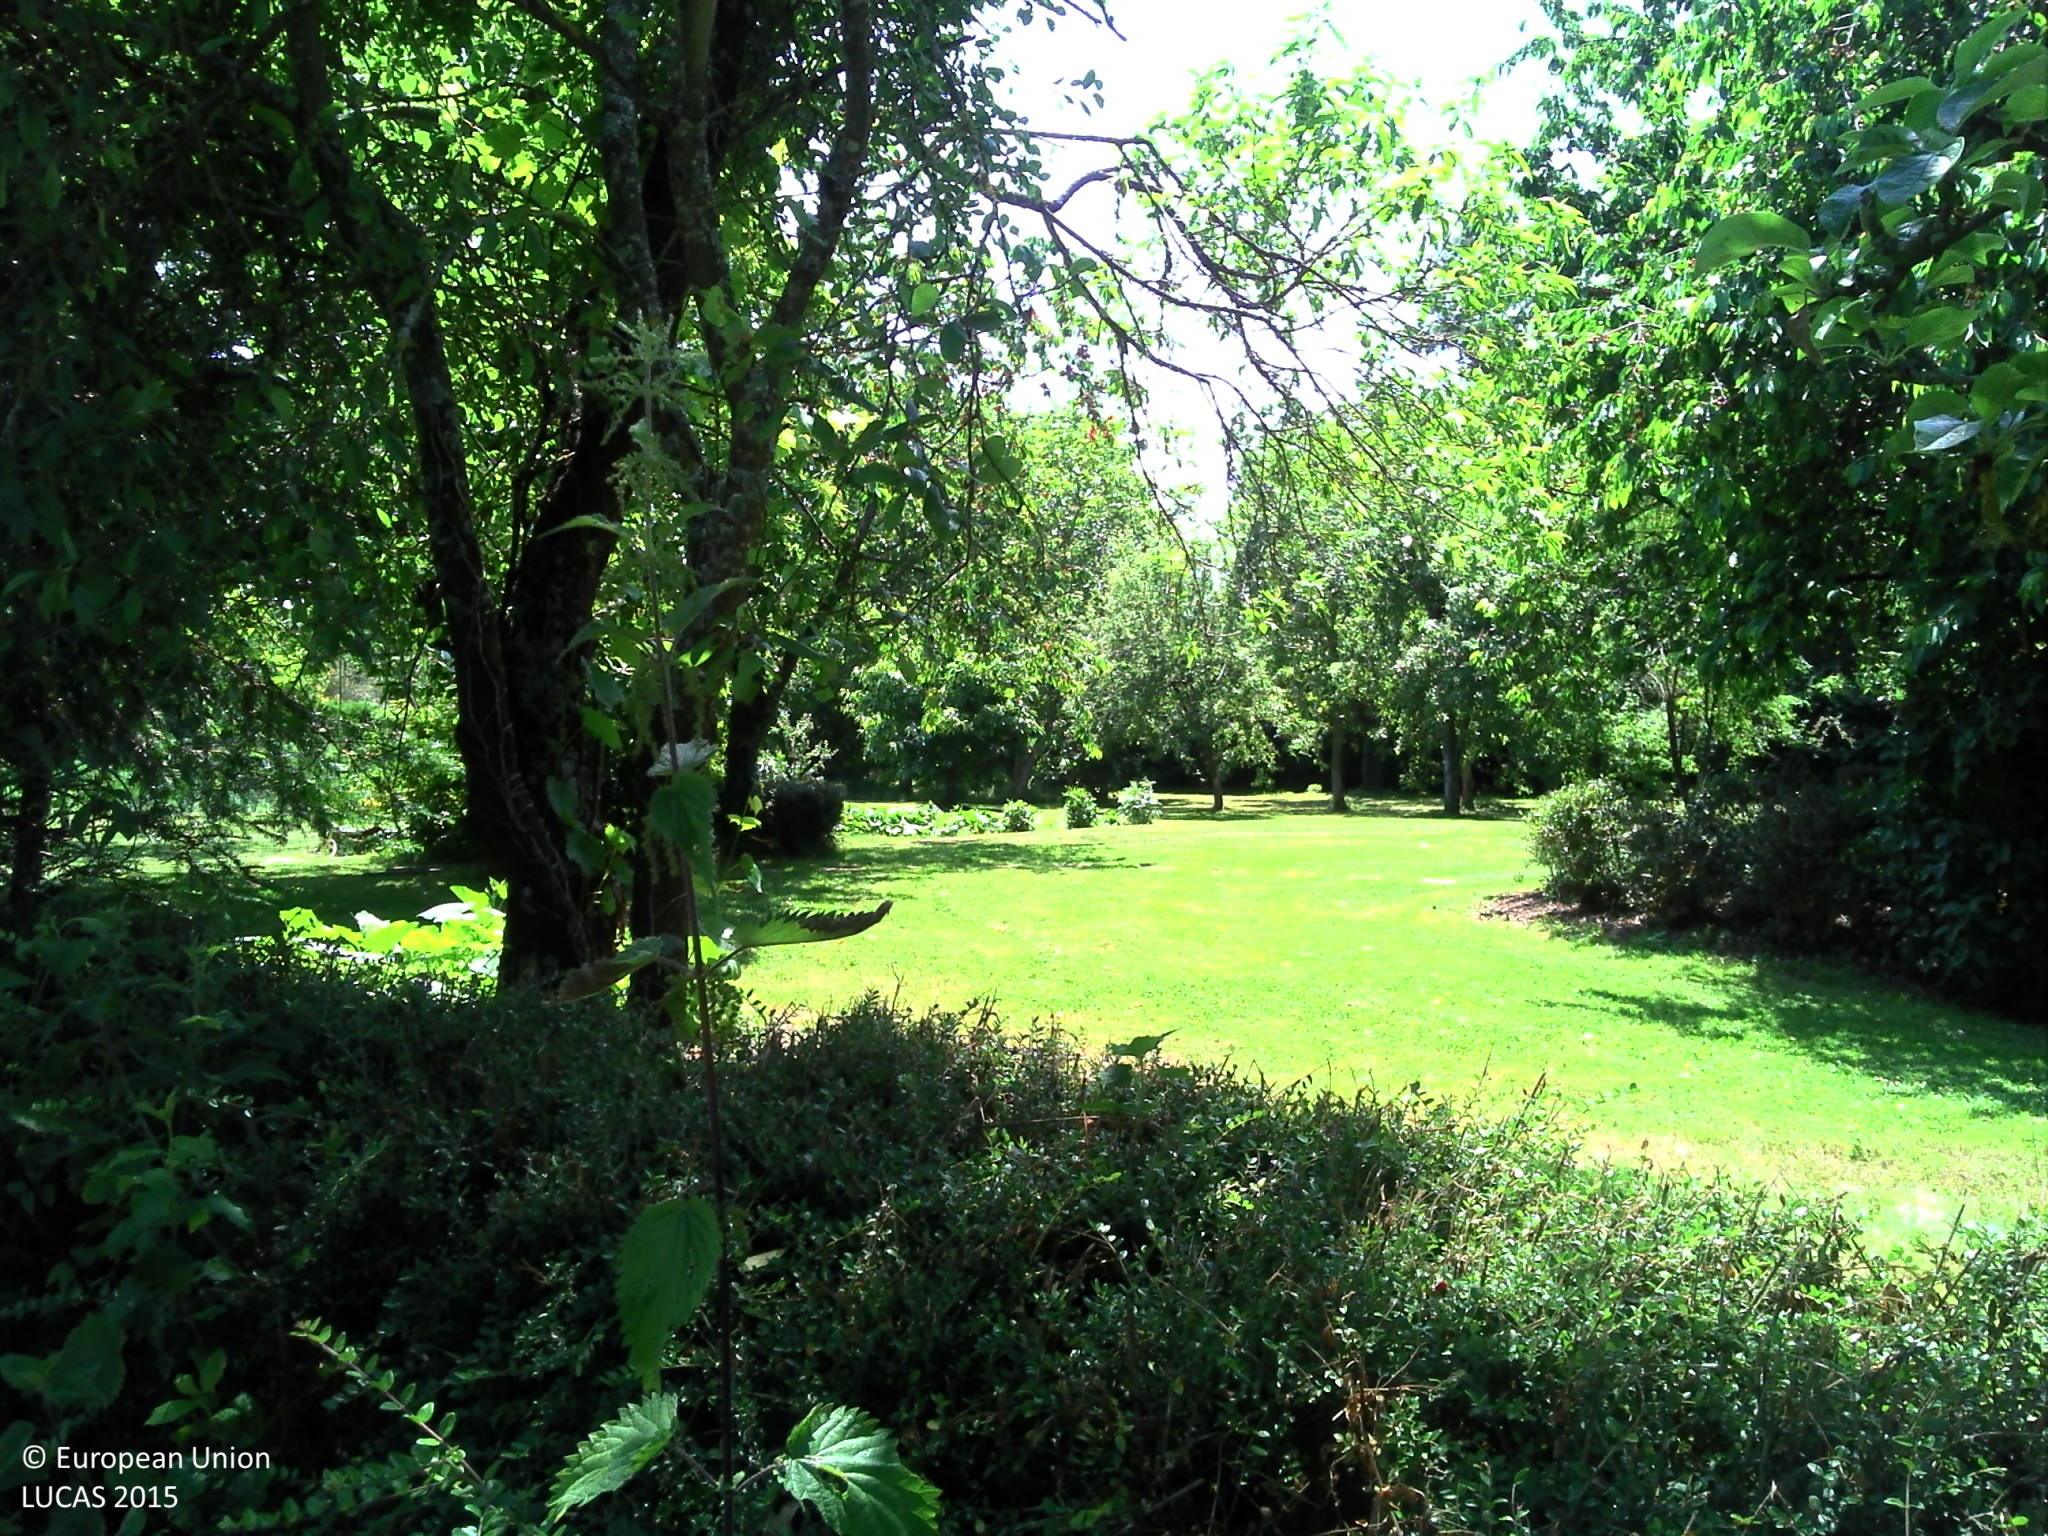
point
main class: Grassland
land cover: Grassland with sparse tree/shrub cover
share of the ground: > 75 %
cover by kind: herbaceous plants 95 %, broadleaved forest trees 5 %
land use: Residential
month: June
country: FR
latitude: 48.0427
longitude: -1.6229
